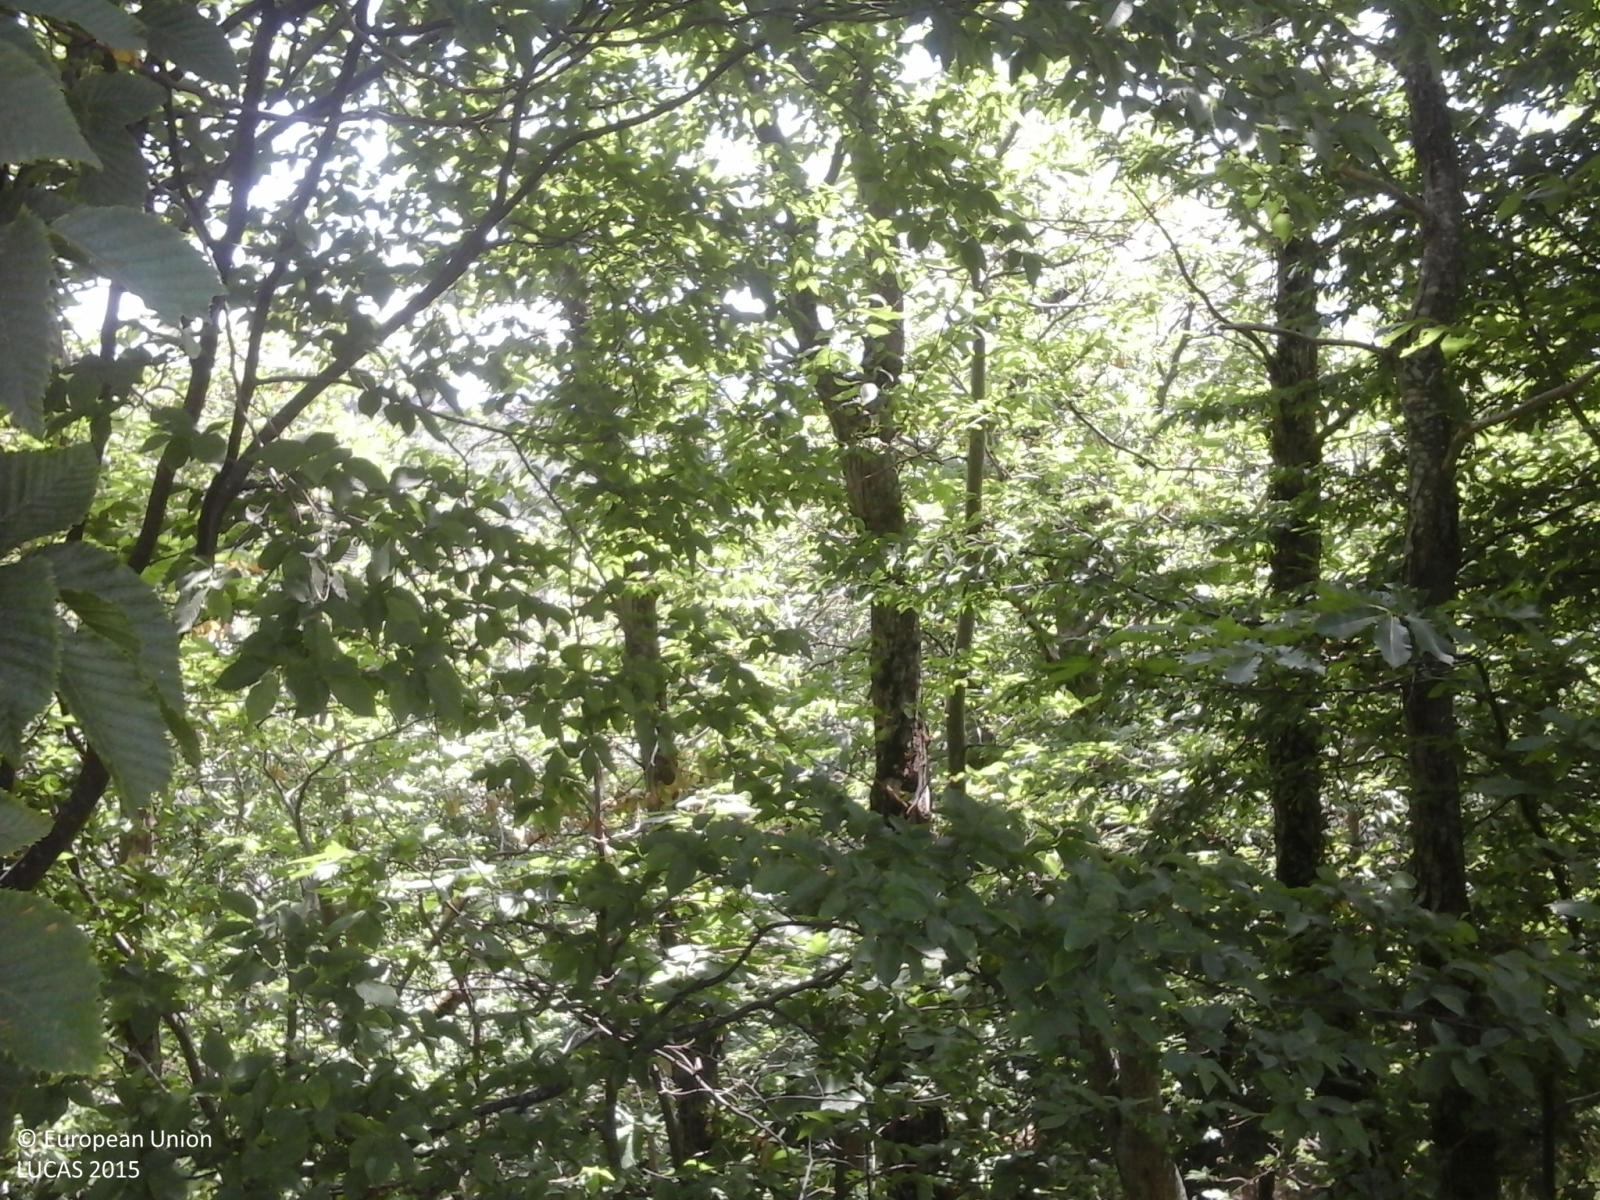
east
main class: Woodland
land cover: Broadleaved woodland
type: thermophilous deciduous forest
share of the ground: > 75 %
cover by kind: broadleaved forest trees 100 %
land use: Forestry
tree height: > 5 m
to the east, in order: Broadleaved woodland
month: July
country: IT
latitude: 44.3681
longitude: 10.3130
